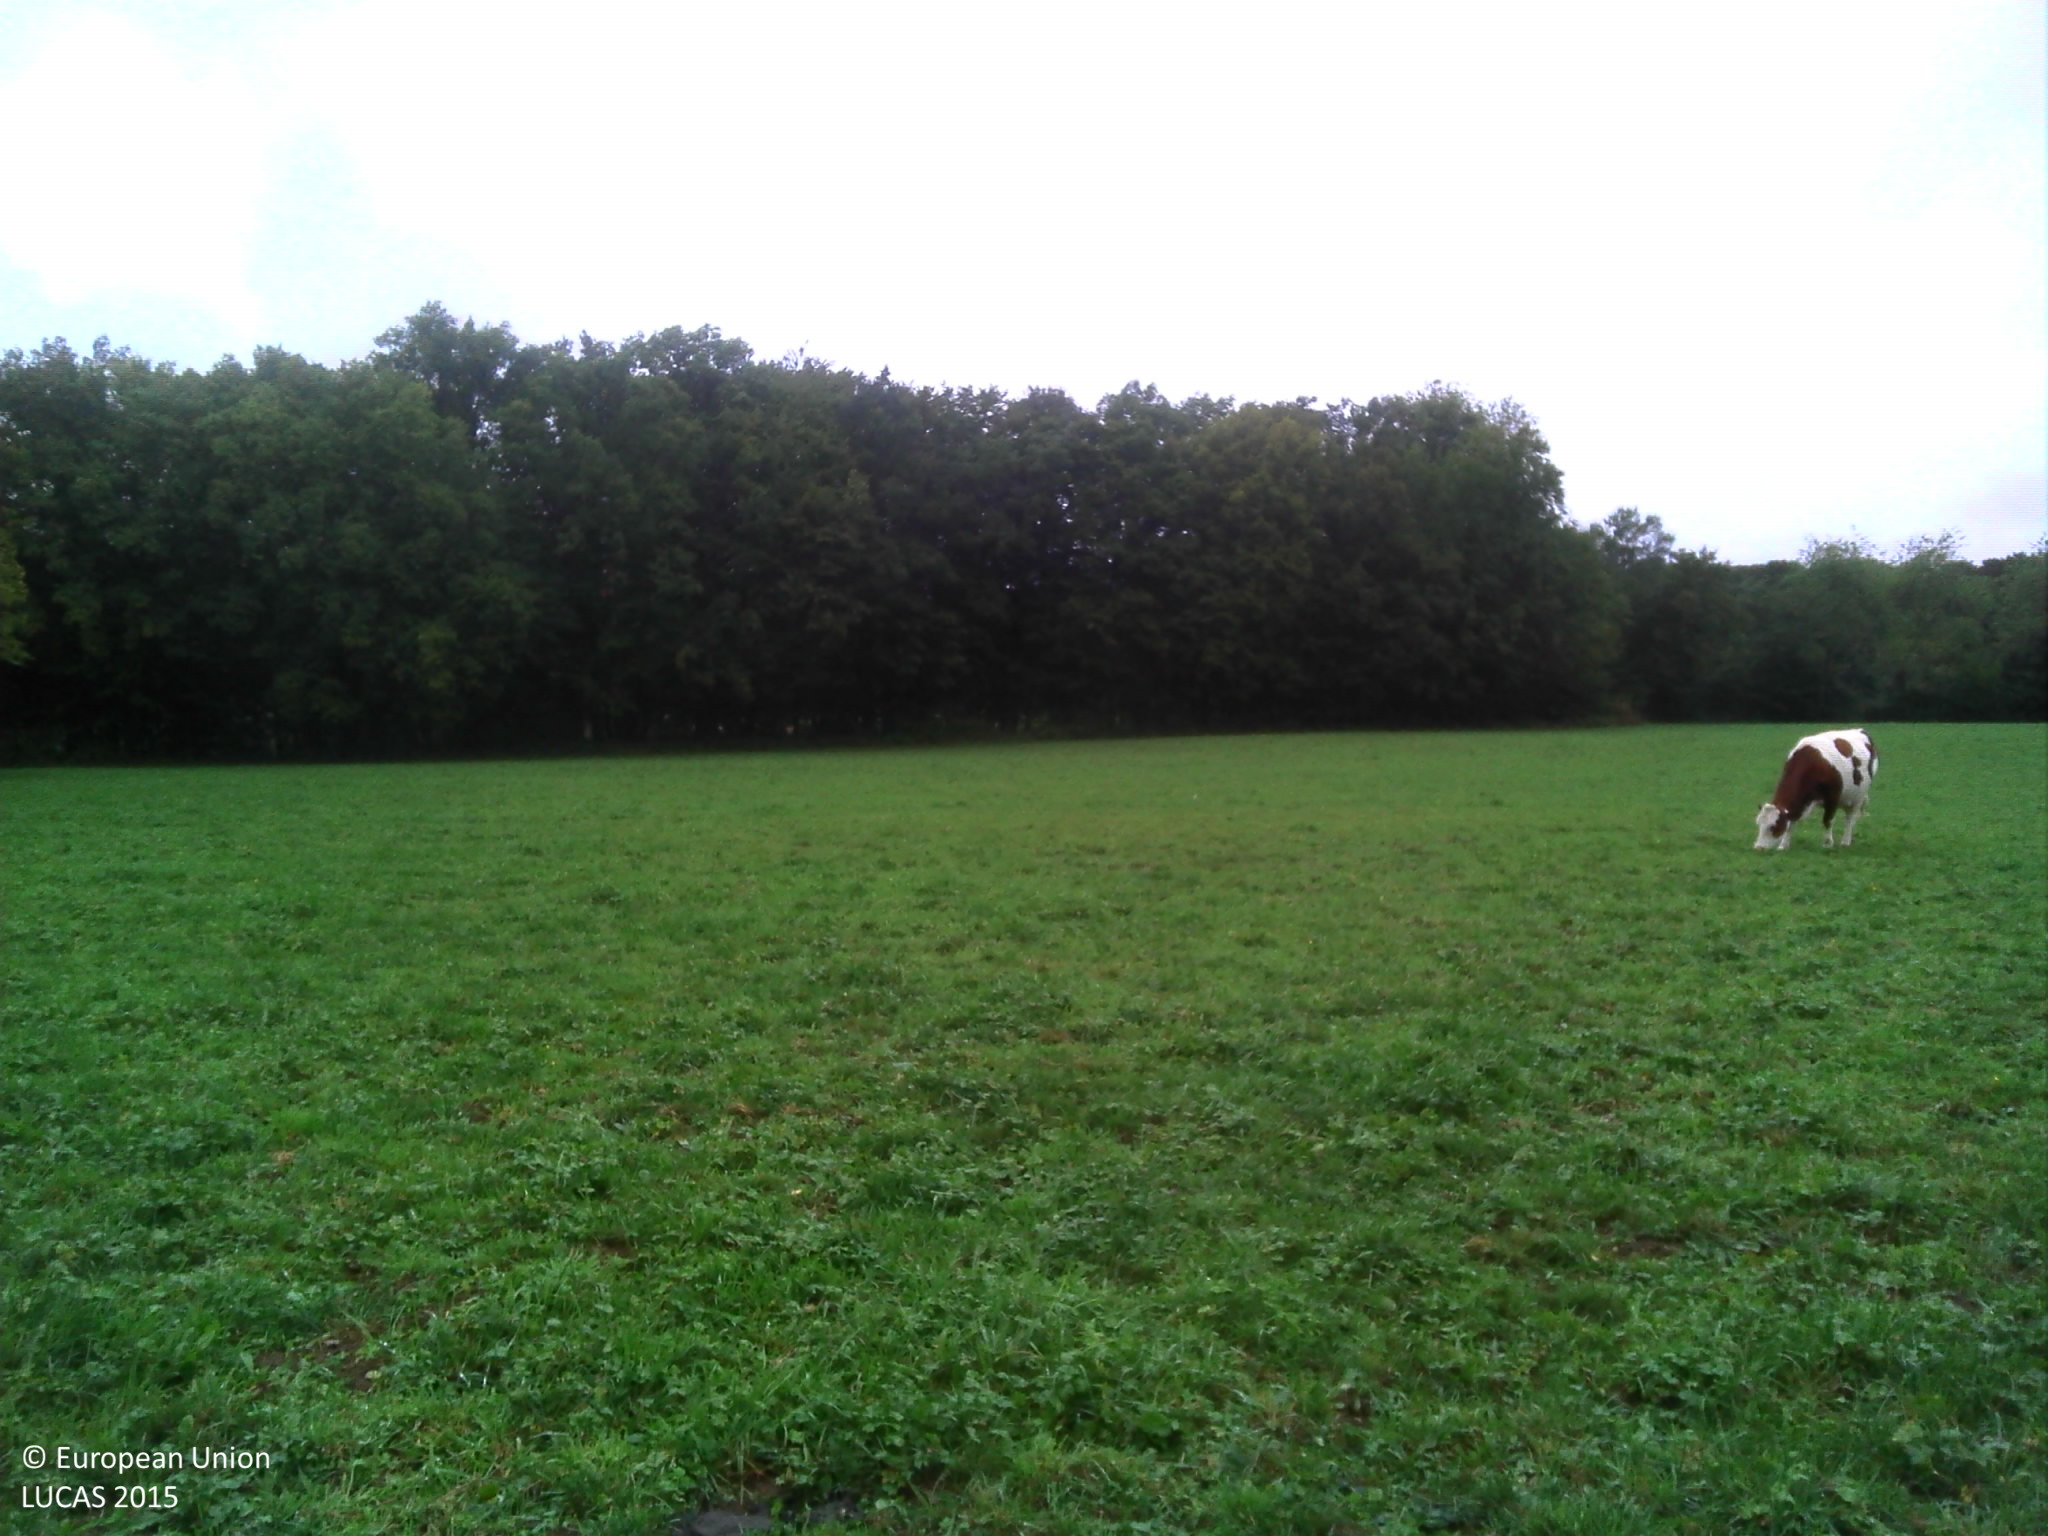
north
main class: Grassland
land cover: Grassland without tree/shrub cover
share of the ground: > 75 %
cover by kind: herbaceous plants 95 %, unconsolidated bare surface 5 %
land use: Agriculture (excluding fallow land and kitchen gardens)
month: September
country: FR
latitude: 47.1505
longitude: 6.2434
